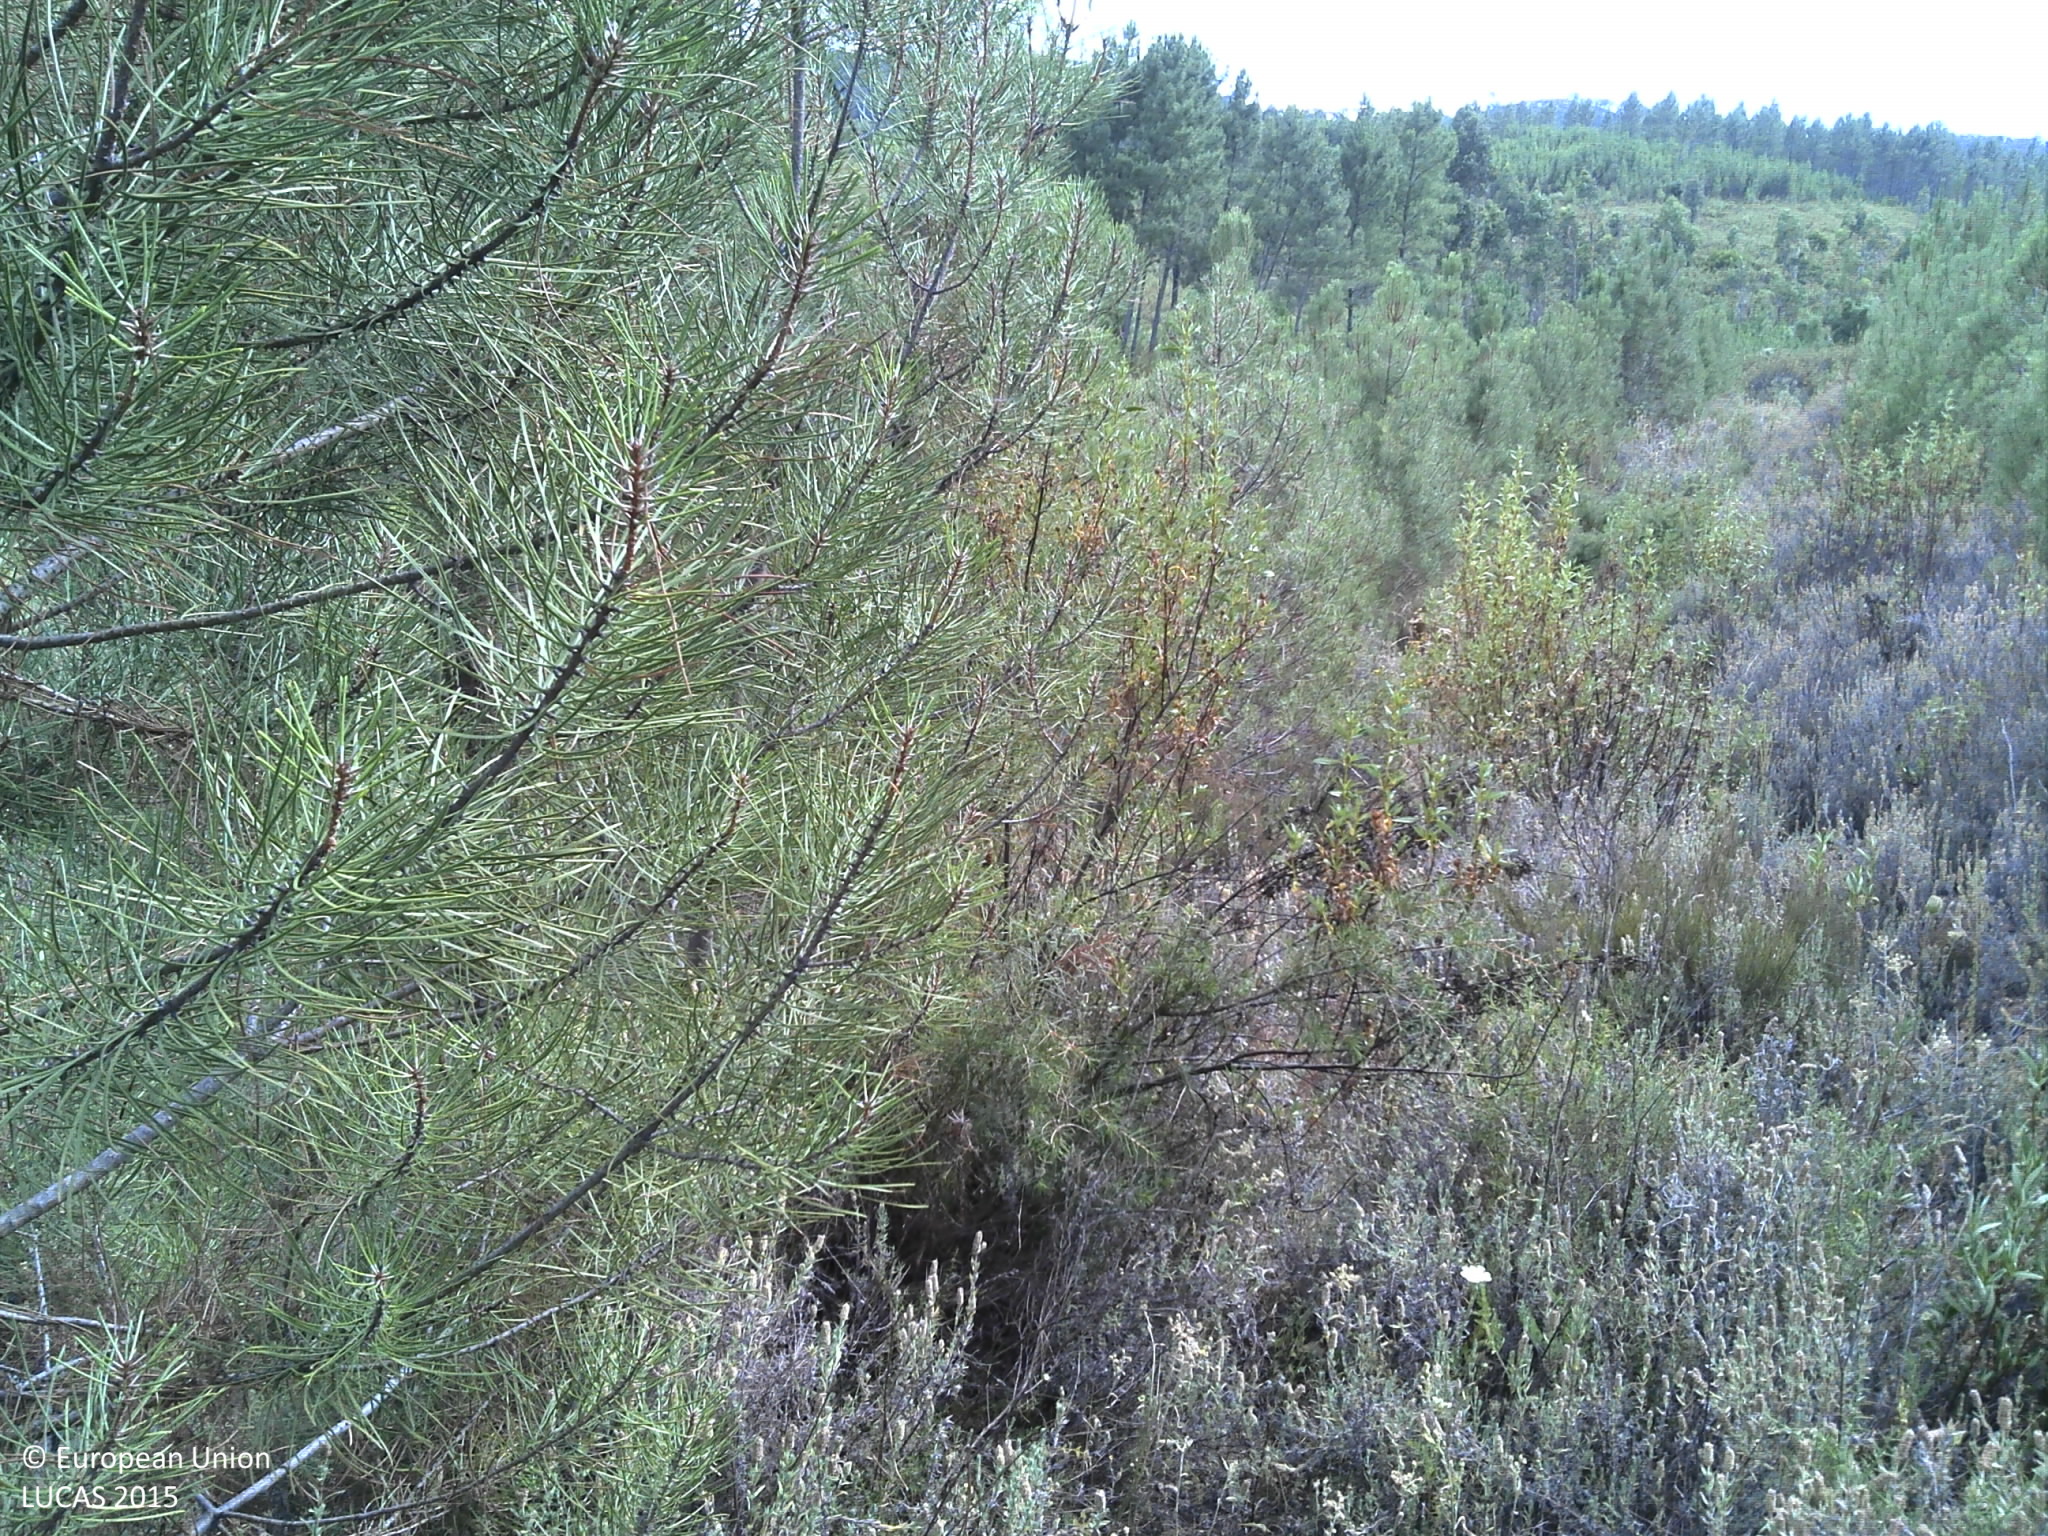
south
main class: Woodland
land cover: Pine dominated coniferous woodland
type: coniferous forest of the mediterranean region
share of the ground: 10 - 25 %
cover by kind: shrubs 60 %, unconsolidated bare surface 25 %, coniferous forest trees 15 %
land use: Forestry
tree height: < 5 m
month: July
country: PT
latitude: 39.6679
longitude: -8.0504
